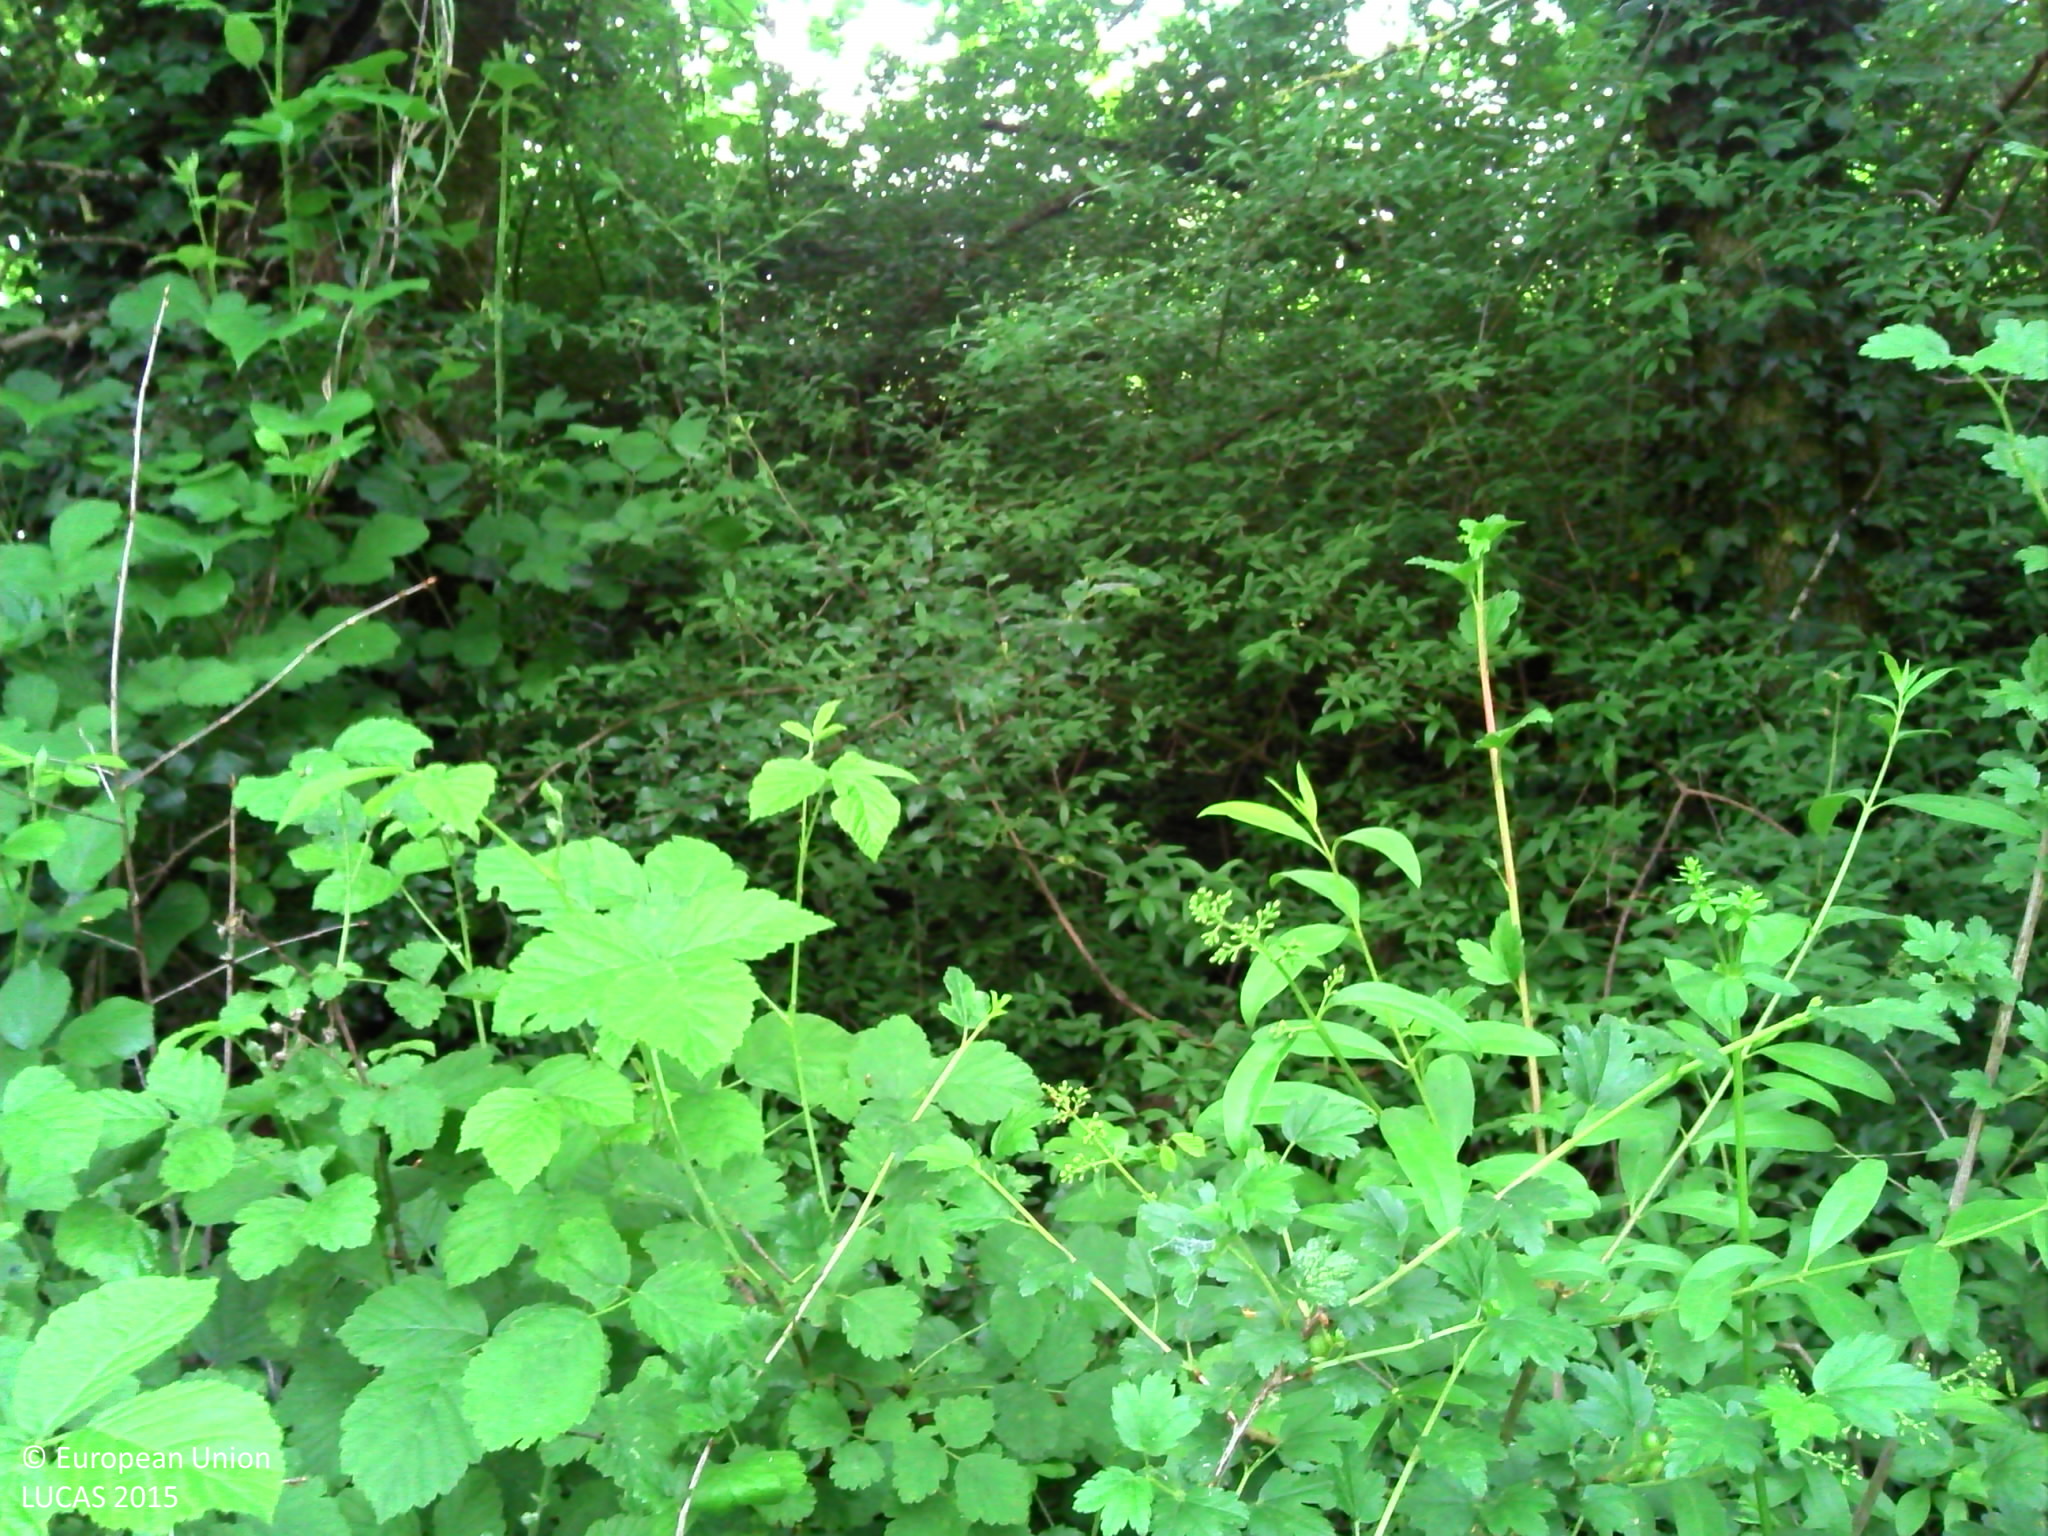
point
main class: Woodland
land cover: Broadleaved woodland
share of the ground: > 75 %
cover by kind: broadleaved forest trees 85 %, shrubs 10 %, lichens and mosses 5 %
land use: Forestry
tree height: > 5 m
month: May
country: FR
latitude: 44.3650
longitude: 2.9650
